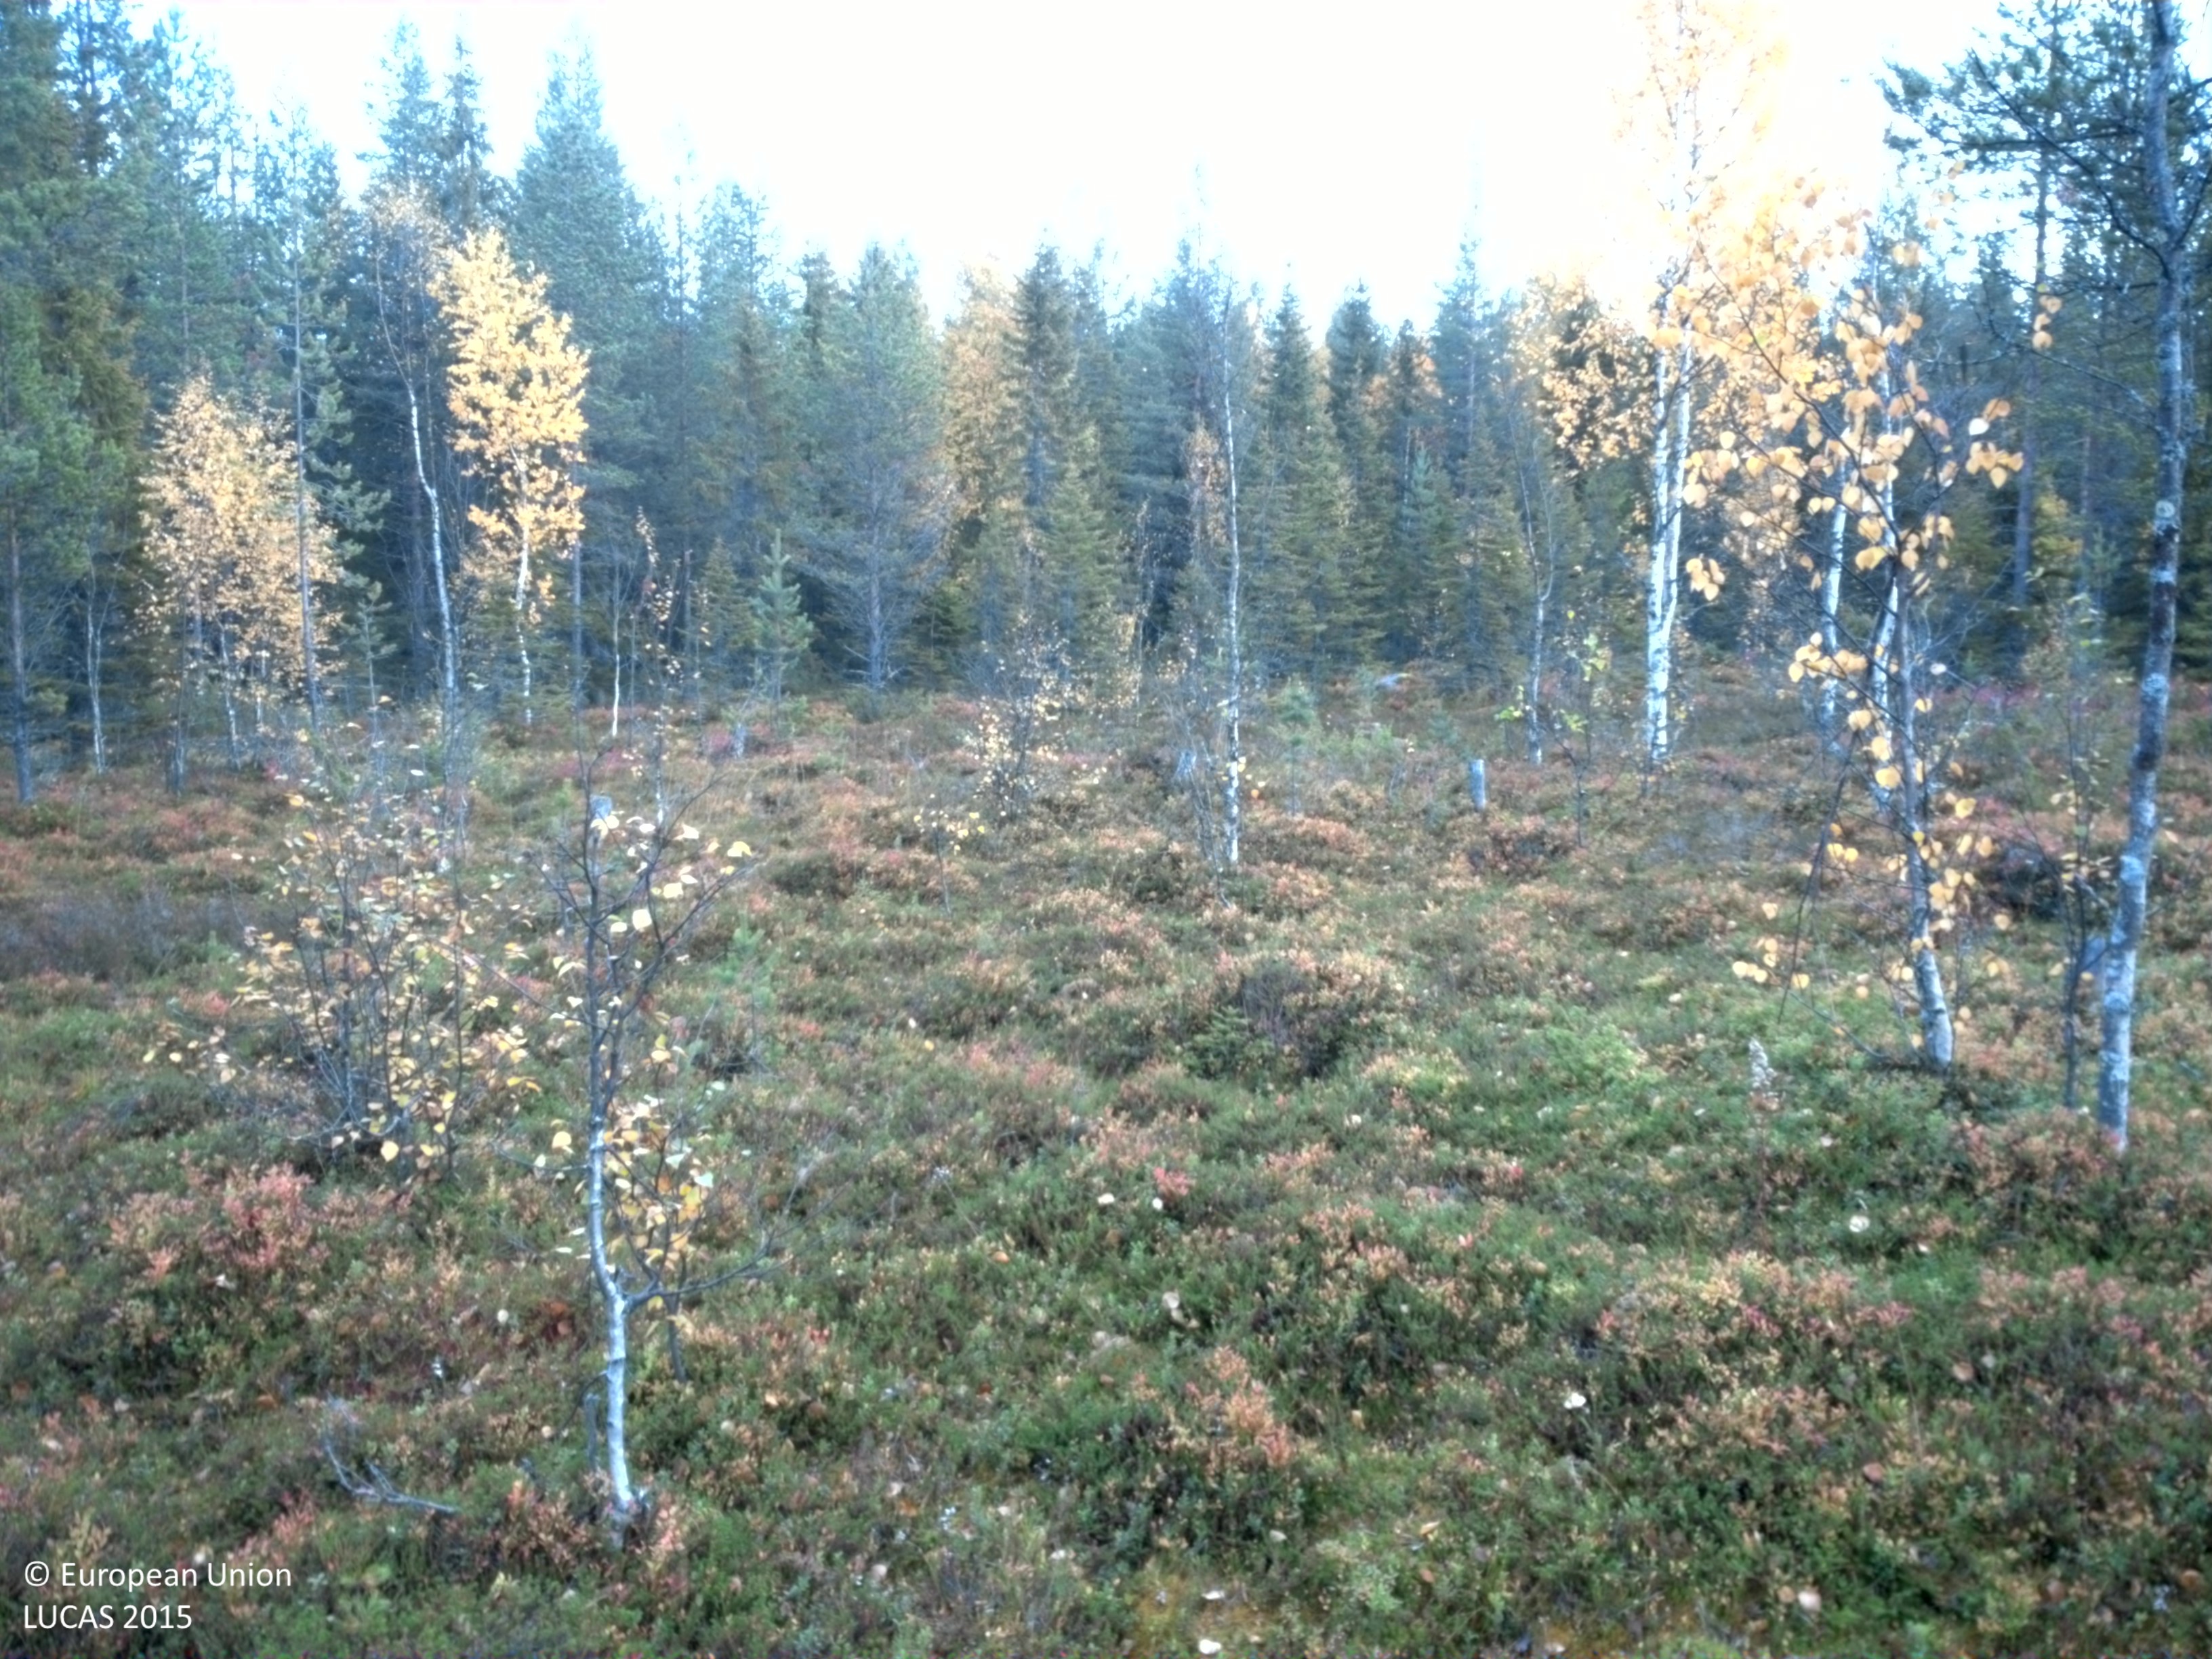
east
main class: Woodland
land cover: Other mixed woodland
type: boreal forest
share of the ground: 10 - 25 %
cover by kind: shrubs 55 %, lichens and mosses 20 %, coniferous forest trees 15 %, broadleaved forest trees 5 %, herbaceous plants 5 %
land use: Forestry
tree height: > 5 m
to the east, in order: Other mixed woodland; Other coniferous woodland; Pine dominated coniferous woodland; Spruce dominated coniferous woodland; Pine dominated coniferous woodland
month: September
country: SE
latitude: 65.0357
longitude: 17.9265
